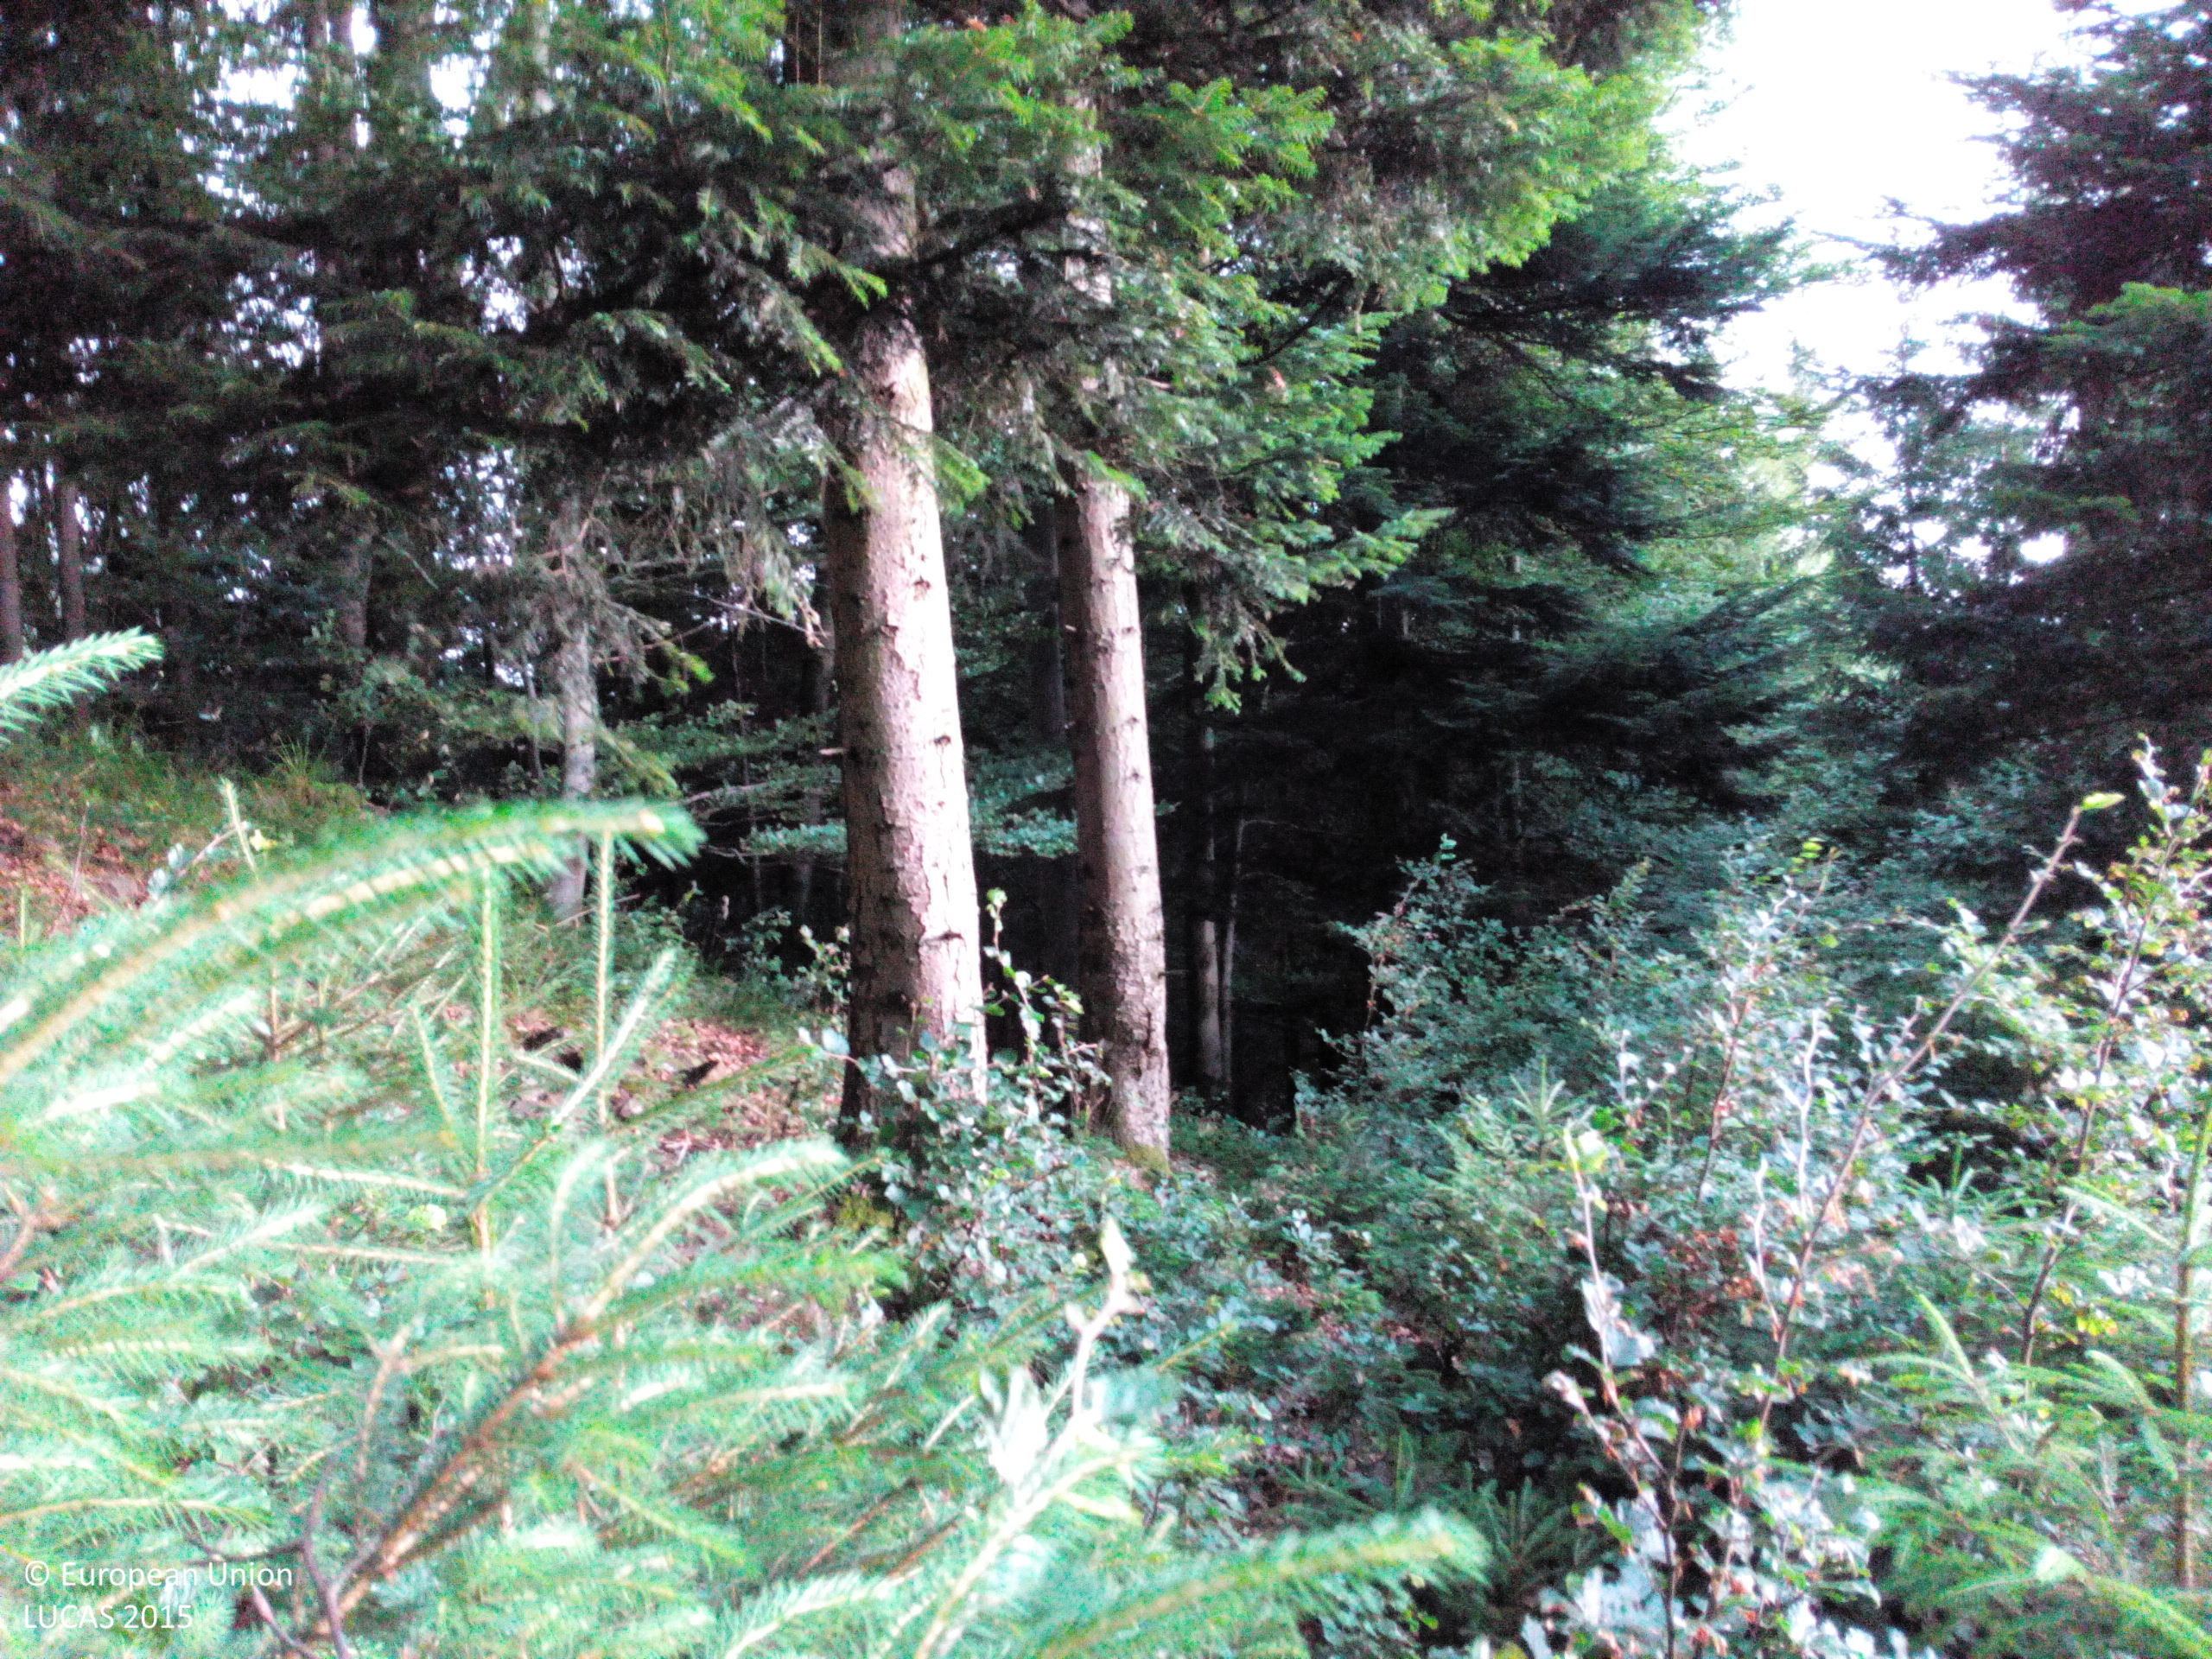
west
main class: Woodland
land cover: Spruce dominated mixed woodland
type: hemiboreal forest and nemoral coniferous forest and mixed broadleaved-coniferous forest
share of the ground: > 75 %
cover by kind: broadleaved forest trees 50 %, coniferous forest trees 35 %, unconsolidated bare surface 10 %, shrubs 5 %
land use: Forestry
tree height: < 5 m
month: July
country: DE
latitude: 48.1353
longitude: 8.1063
